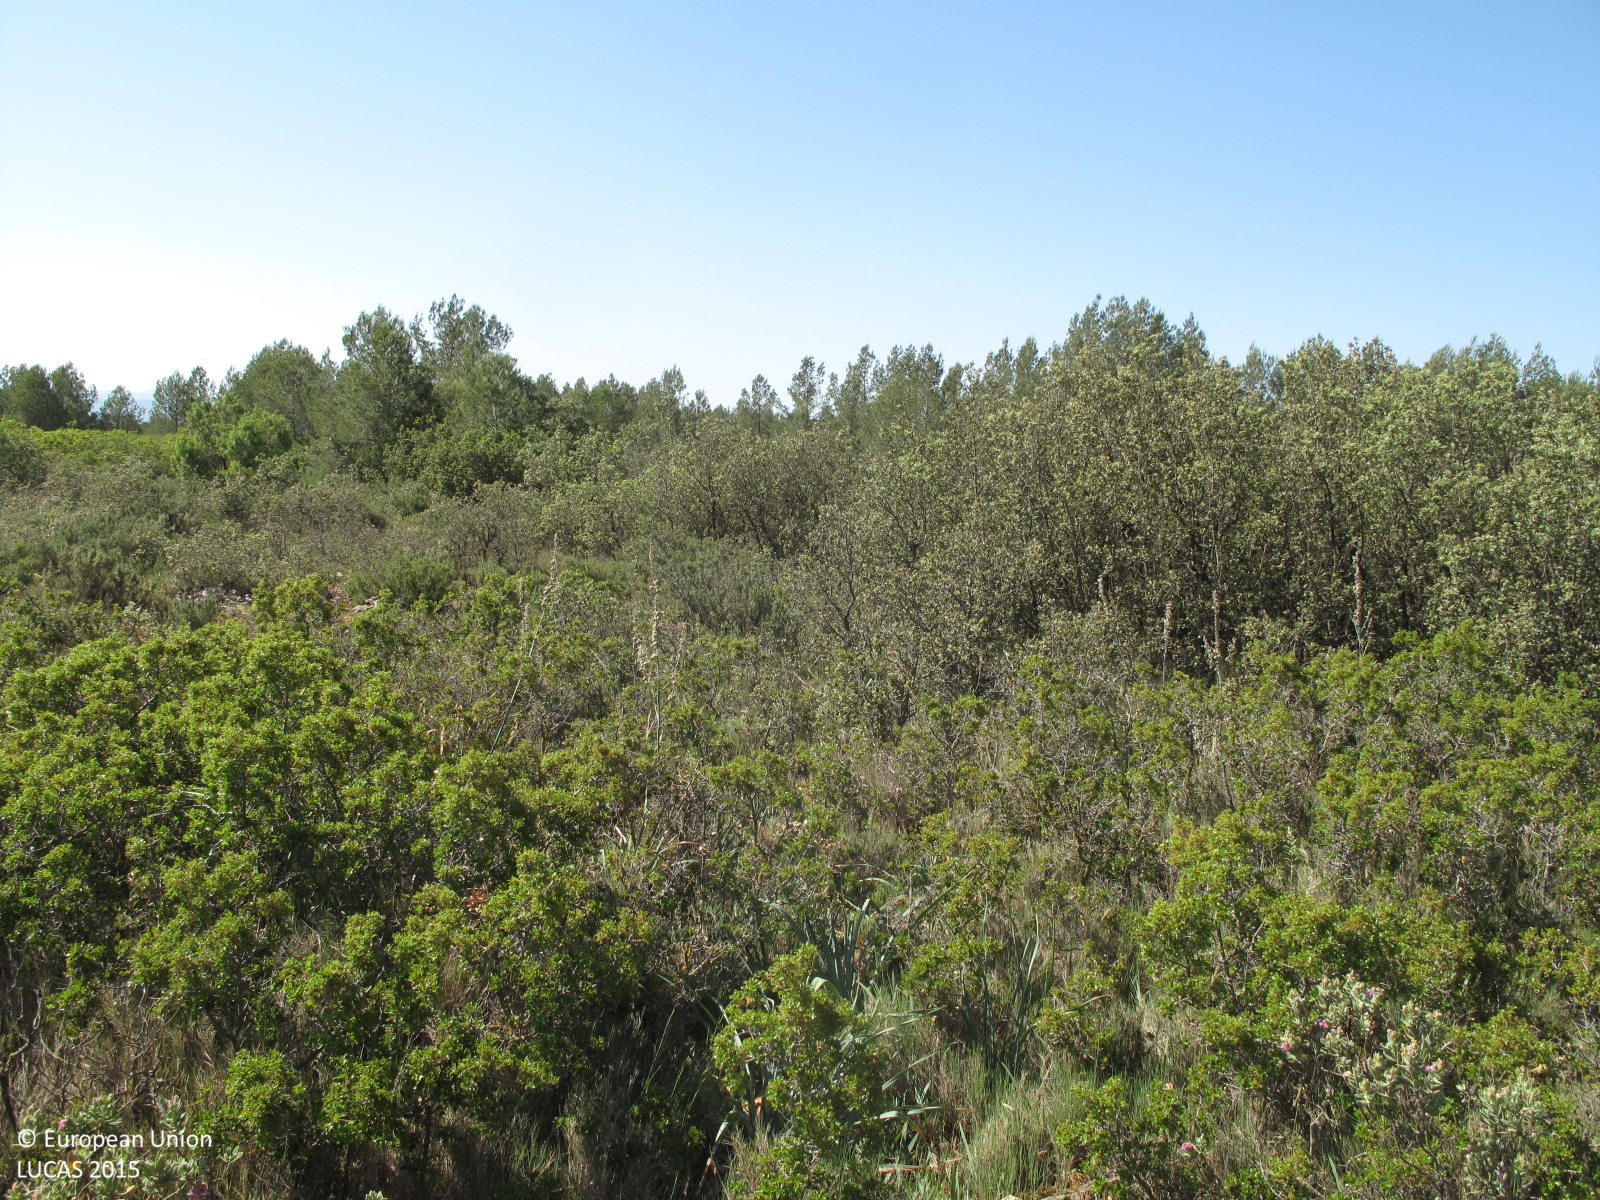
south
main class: Shrubland
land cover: Shrubland with sparse tree cover
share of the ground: 50 - 75 %
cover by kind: shrubs 55 %, herbaceous plants 20 %, consolidated bare surface 20 %, coniferous forest trees 5 %
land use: Semi-natural and natural areas not in use
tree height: < 5 m
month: May
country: ES
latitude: 38.9569
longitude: -0.8064
